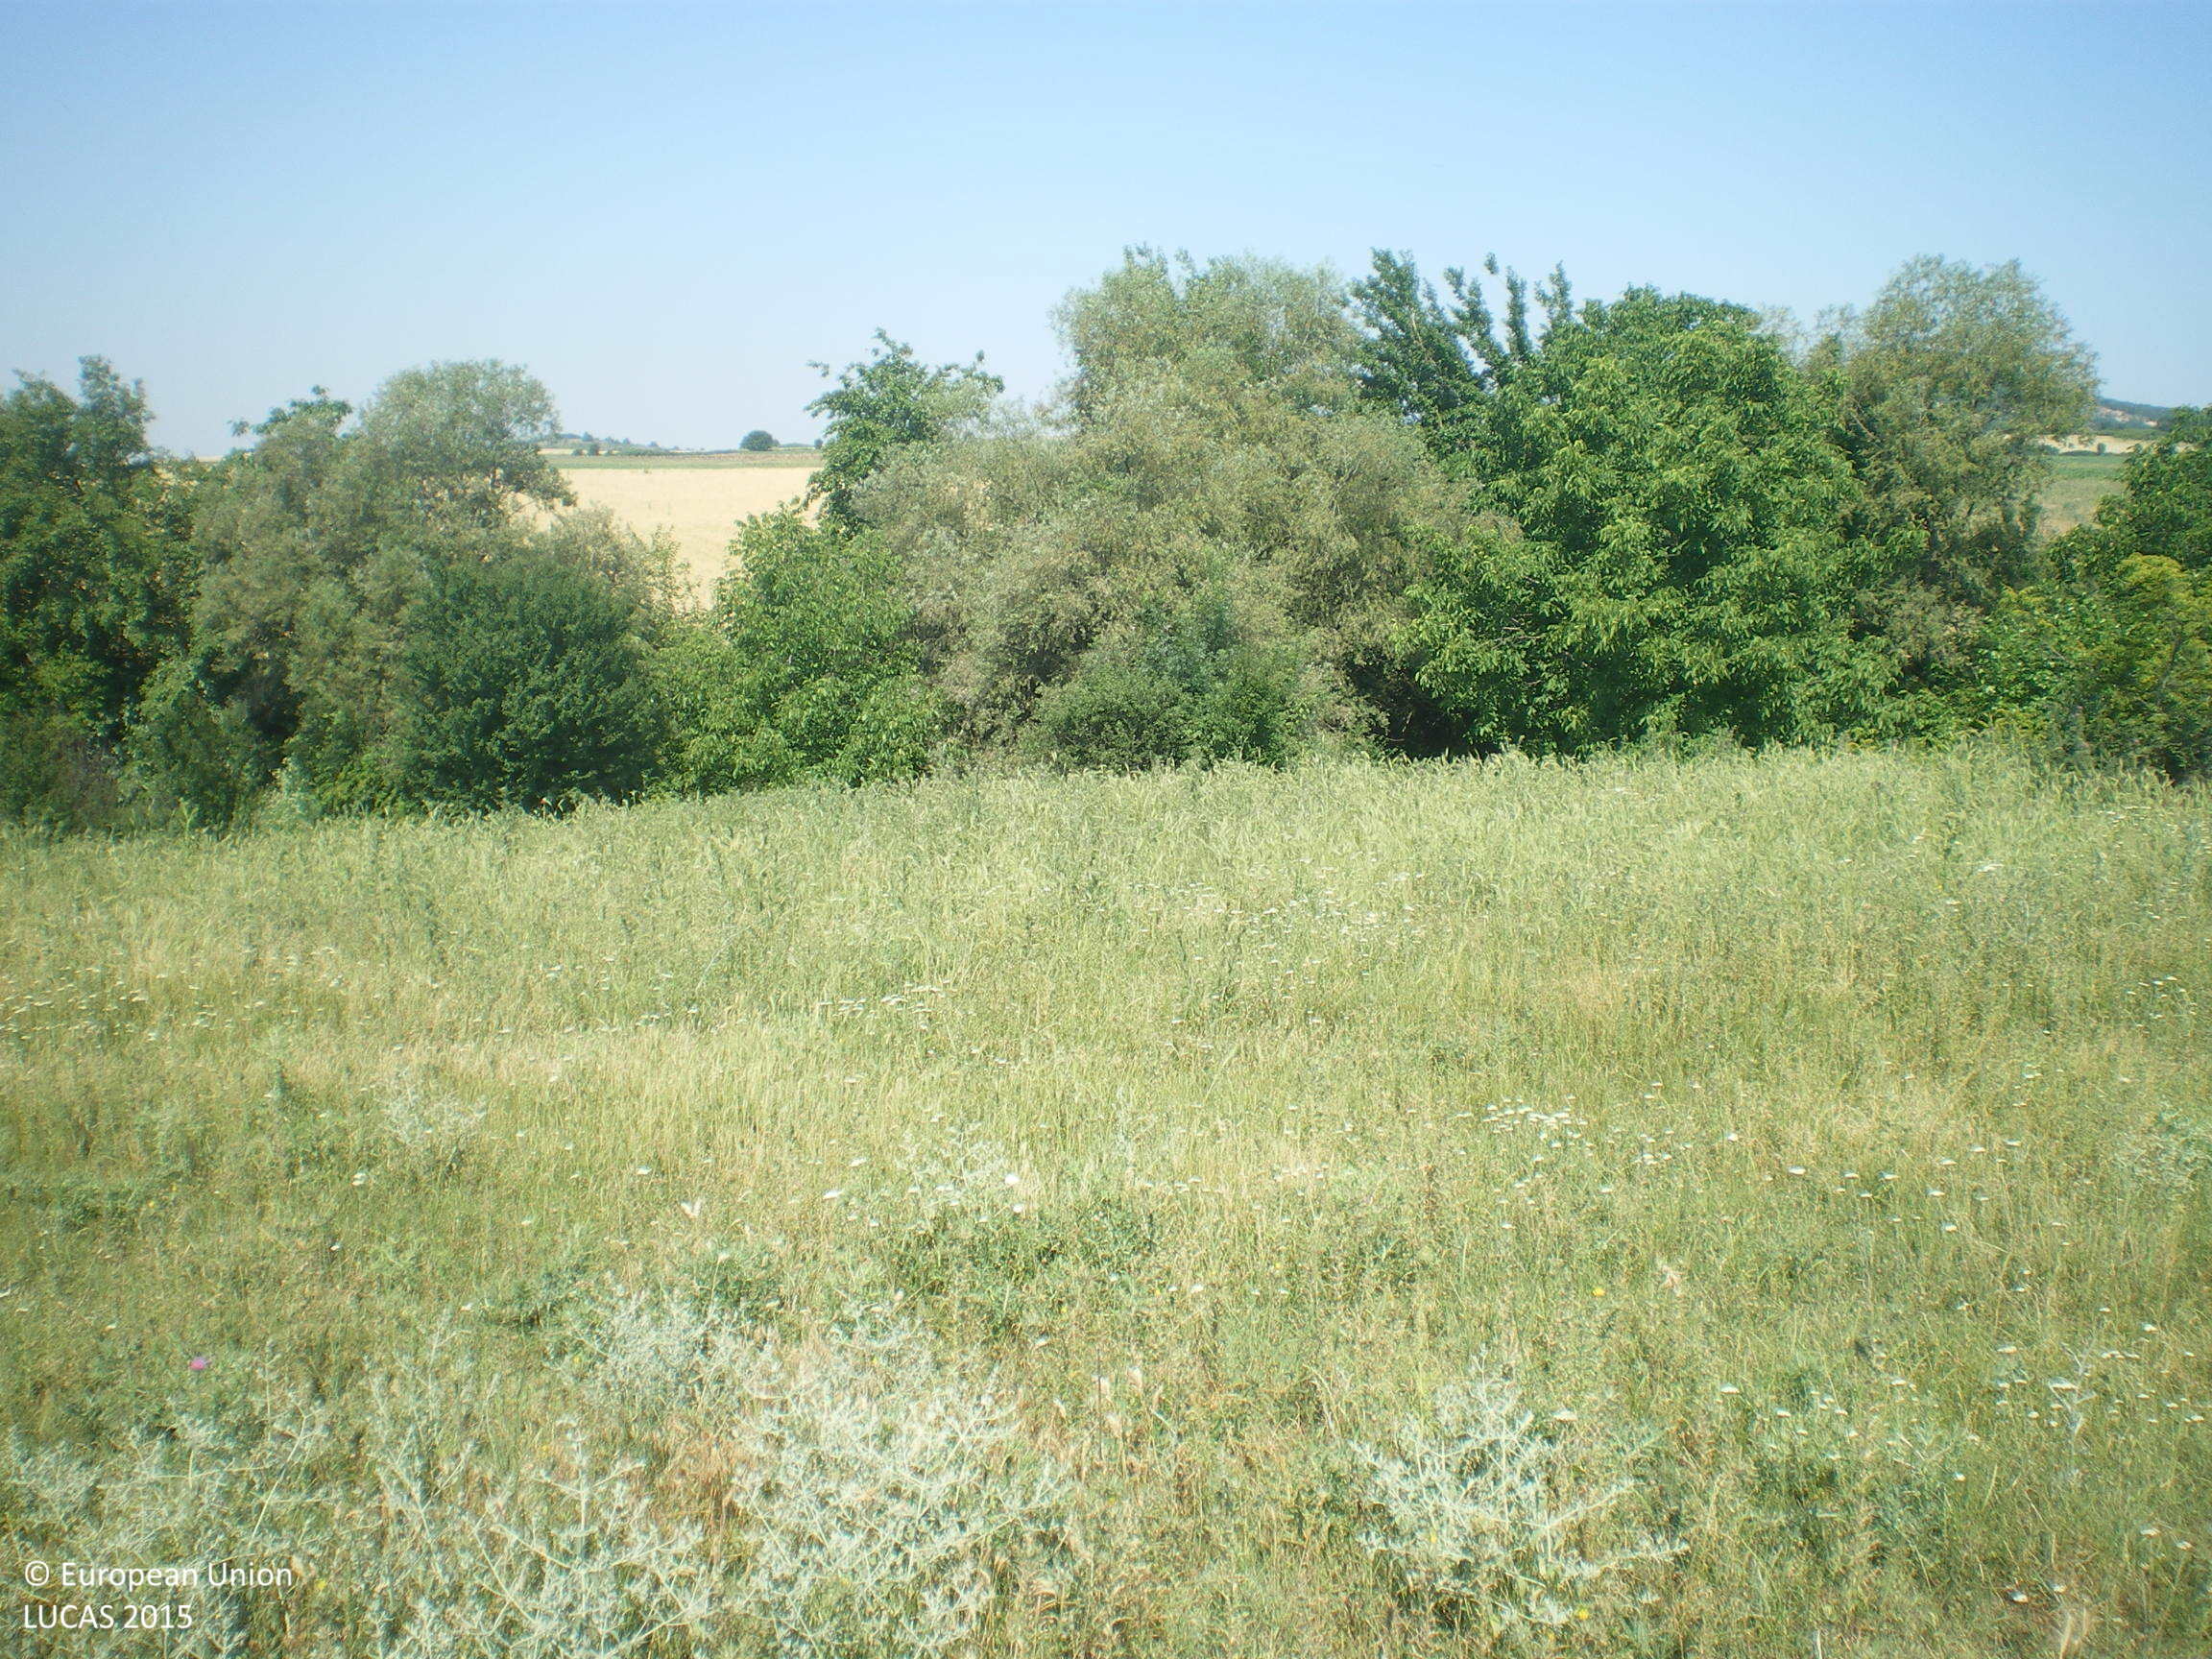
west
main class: Grassland
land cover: Spontaneously vegetated surfaces
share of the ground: > 75 %
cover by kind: herbaceous plants 100 %
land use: Fallow land
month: June
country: BG
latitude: 42.3327
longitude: 25.1464
